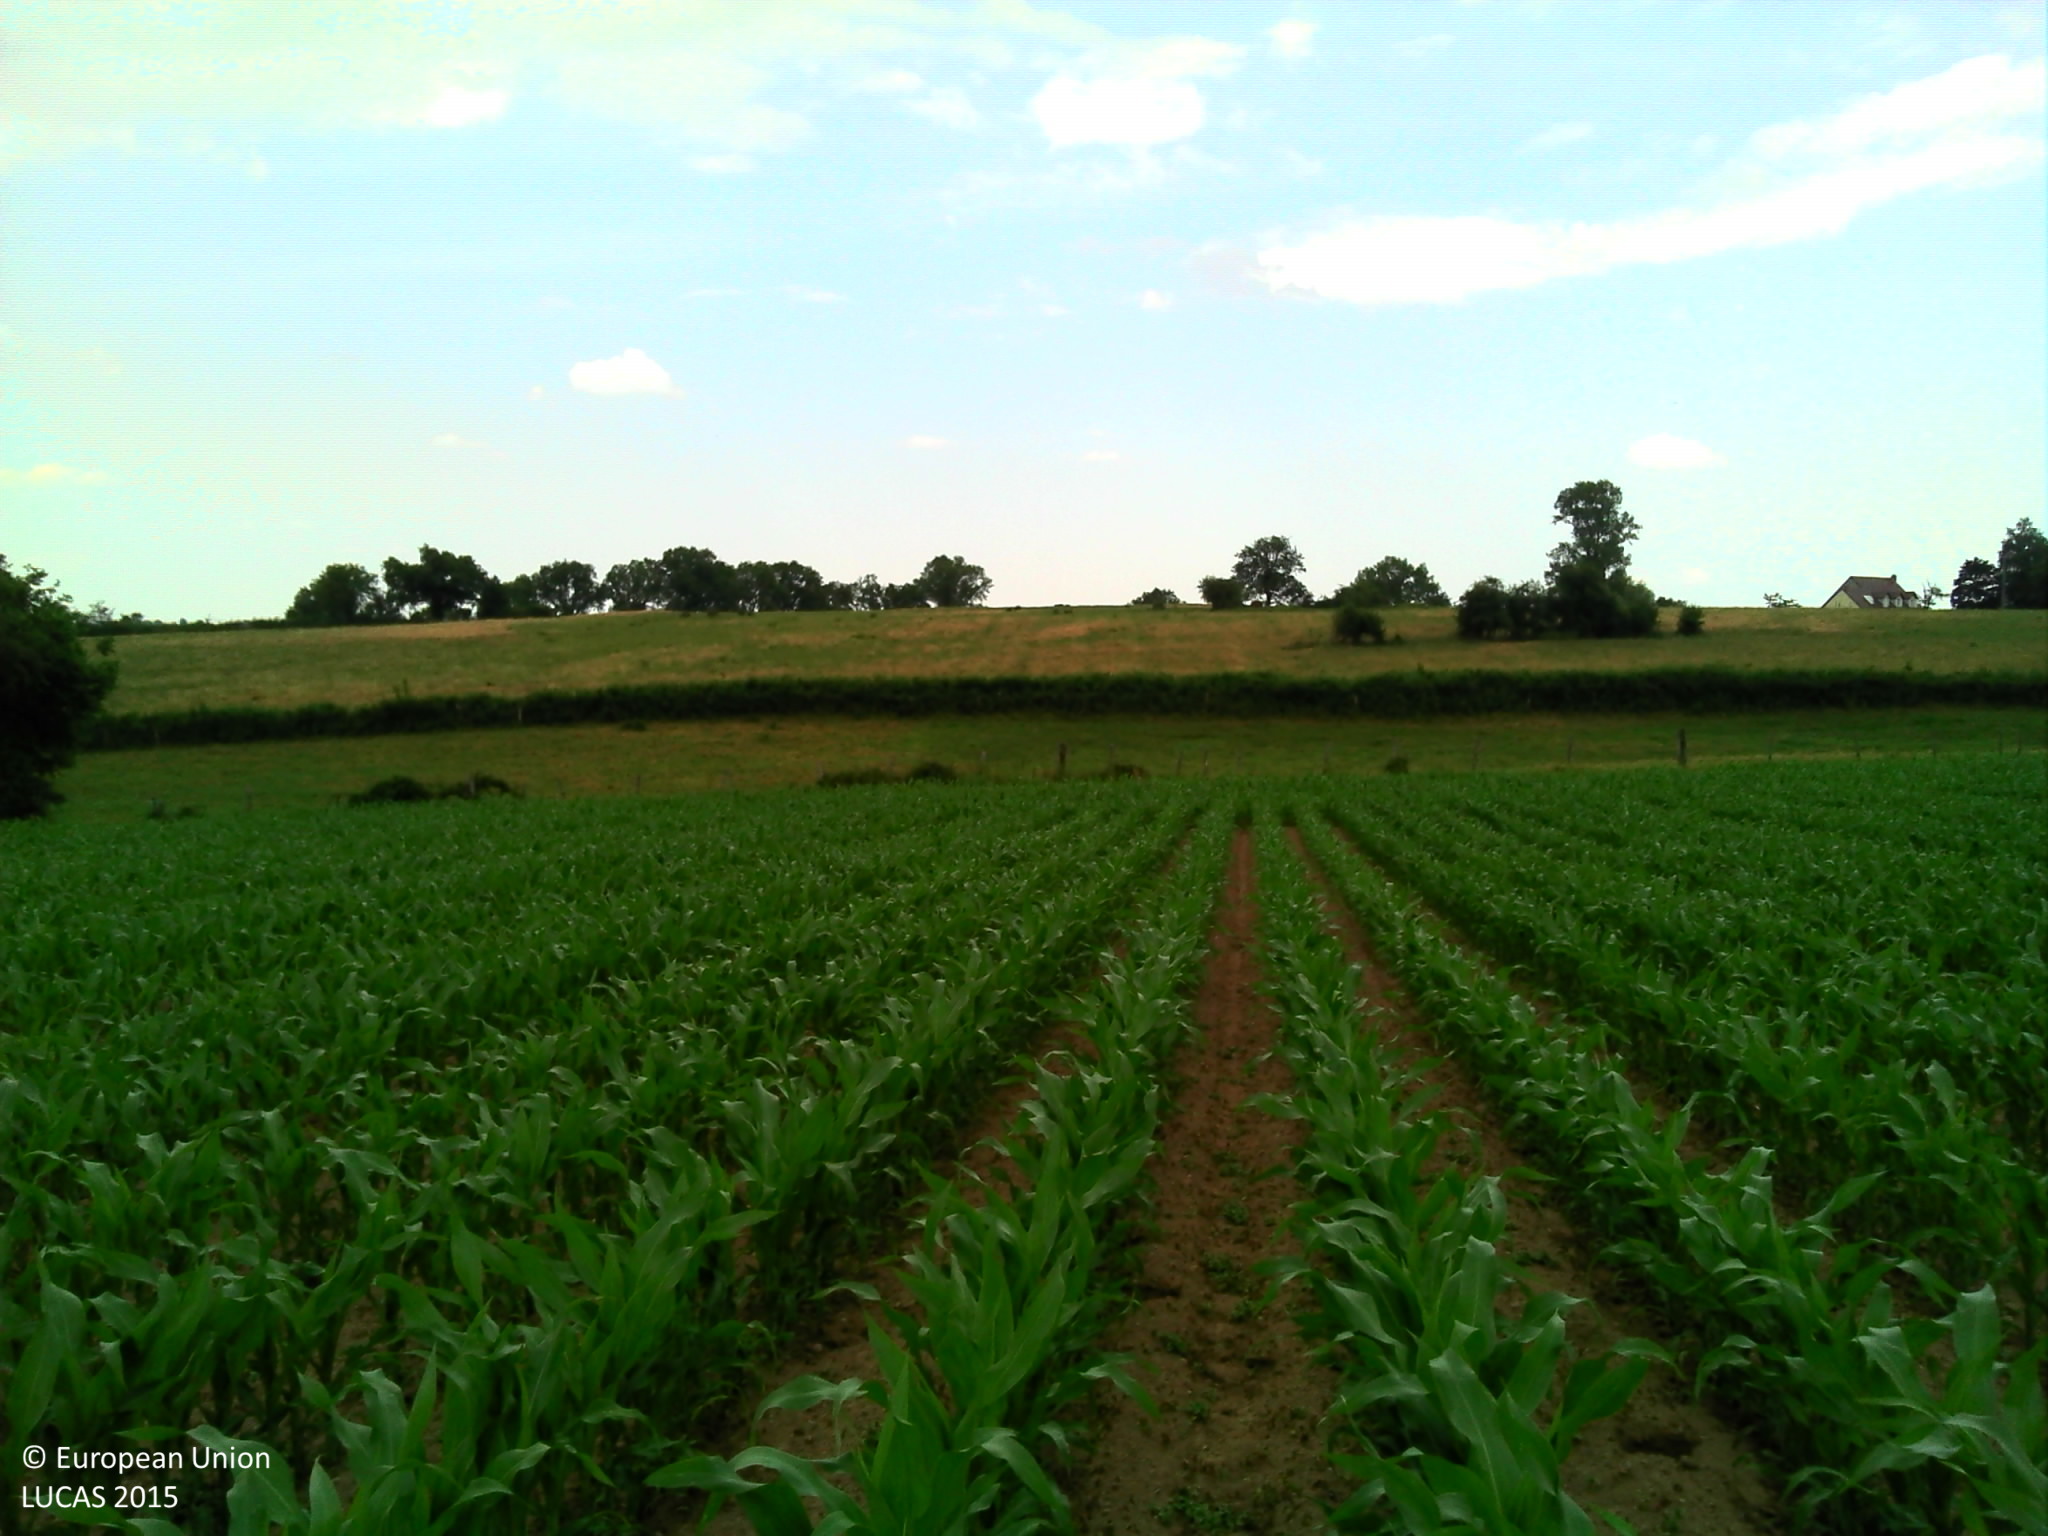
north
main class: Cropland
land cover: Maize
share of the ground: 25 - 50 %
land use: Agriculture (excluding fallow land and kitchen gardens)
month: June
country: FR
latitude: 46.3238
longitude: 3.0491
